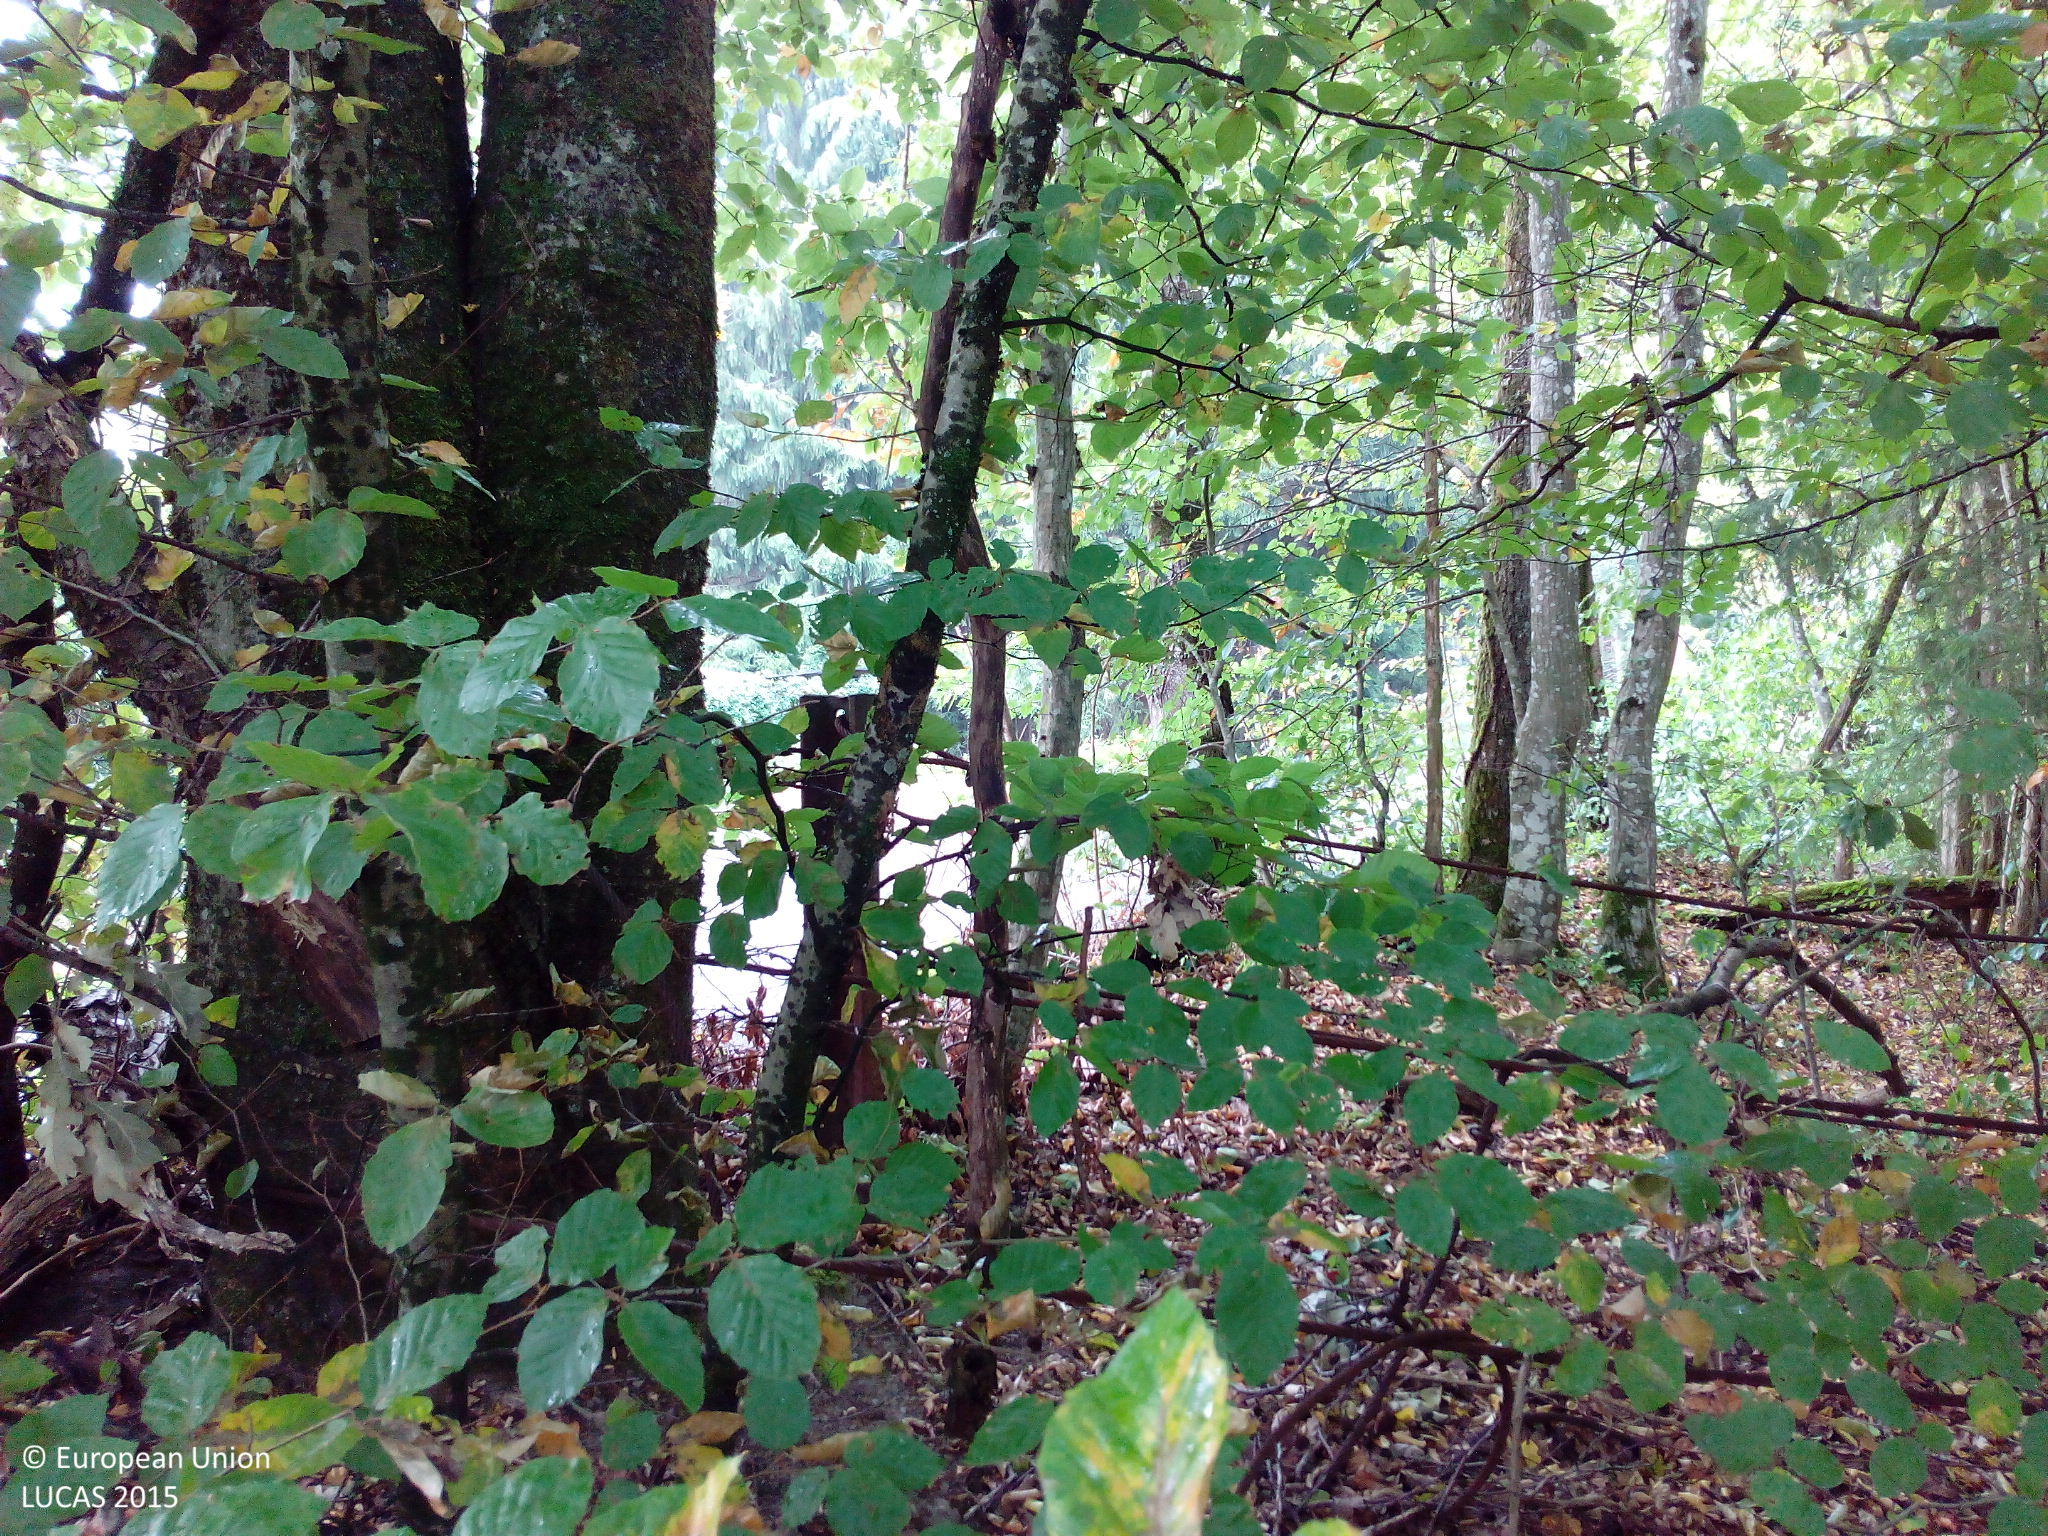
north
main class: Woodland
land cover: Broadleaved woodland
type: beech forest
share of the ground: > 75 %
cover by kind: broadleaved forest trees 80 %, herbaceous plants 20 %
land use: Abandoned areas
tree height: > 5 m
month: August
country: DE
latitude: 47.5956
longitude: 8.1262
